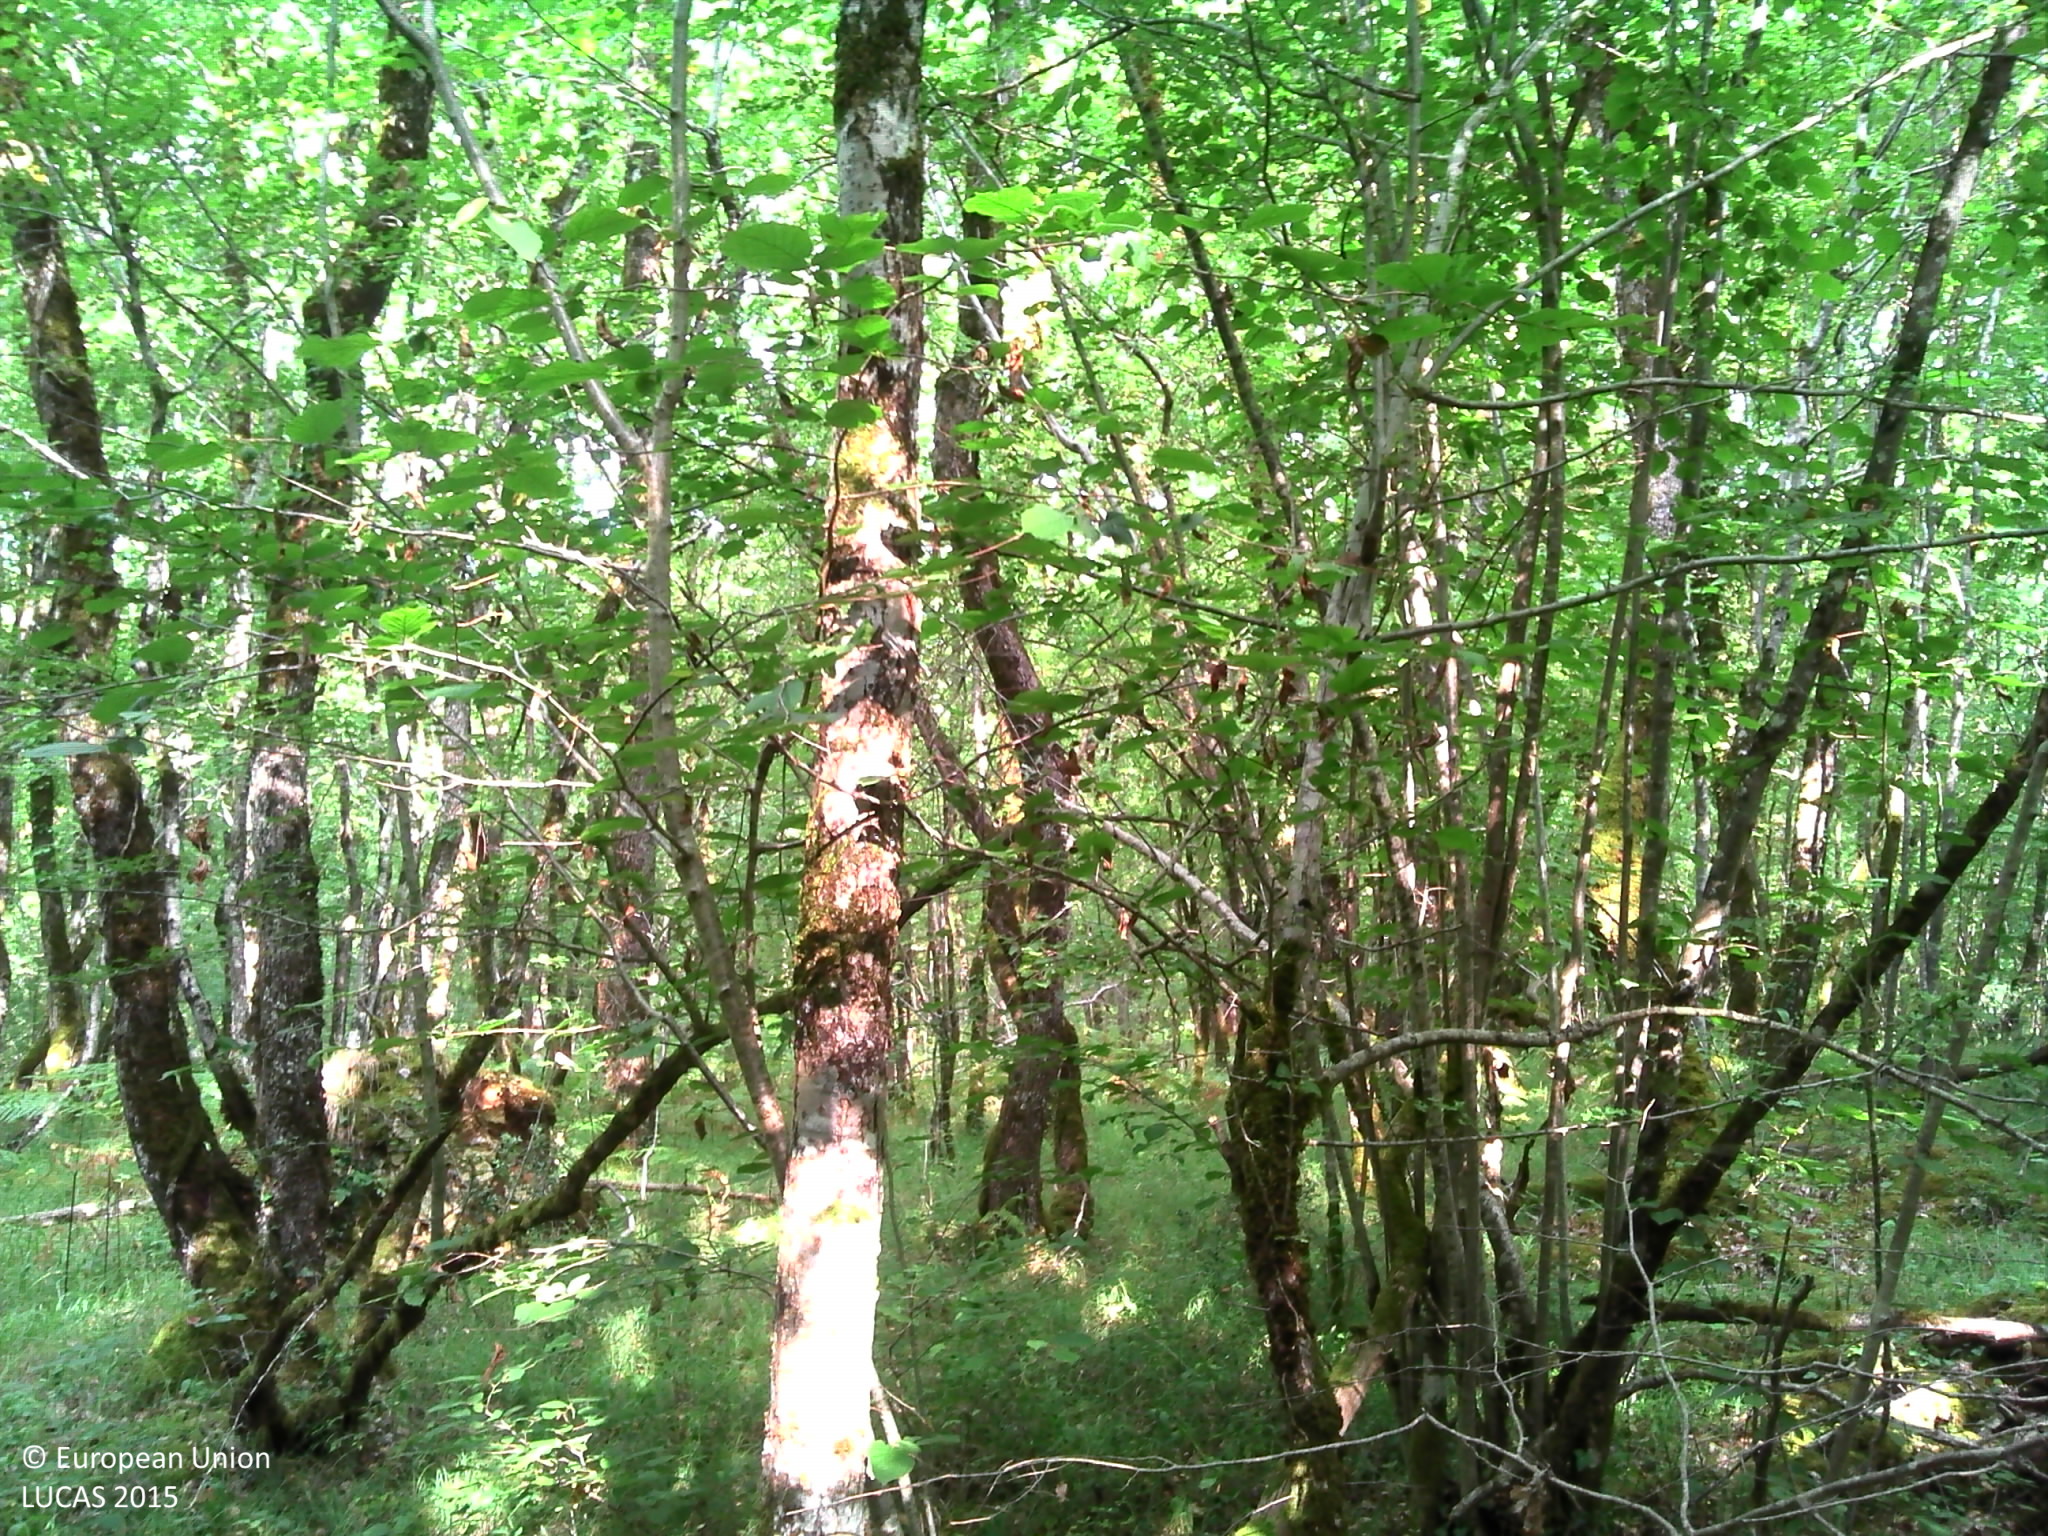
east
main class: Woodland
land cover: Broadleaved woodland
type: mesophytic deciduous forest
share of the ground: > 75 %
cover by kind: broadleaved forest trees 70 %, herbaceous plants 20 %, shrubs 5 %, lichens and mosses 5 %
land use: Forestry
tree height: > 5 m
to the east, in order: Broadleaved woodland; Fences; Tracks; Broadleaved woodland
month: August
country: FR
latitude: 45.4479
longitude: 0.4100
